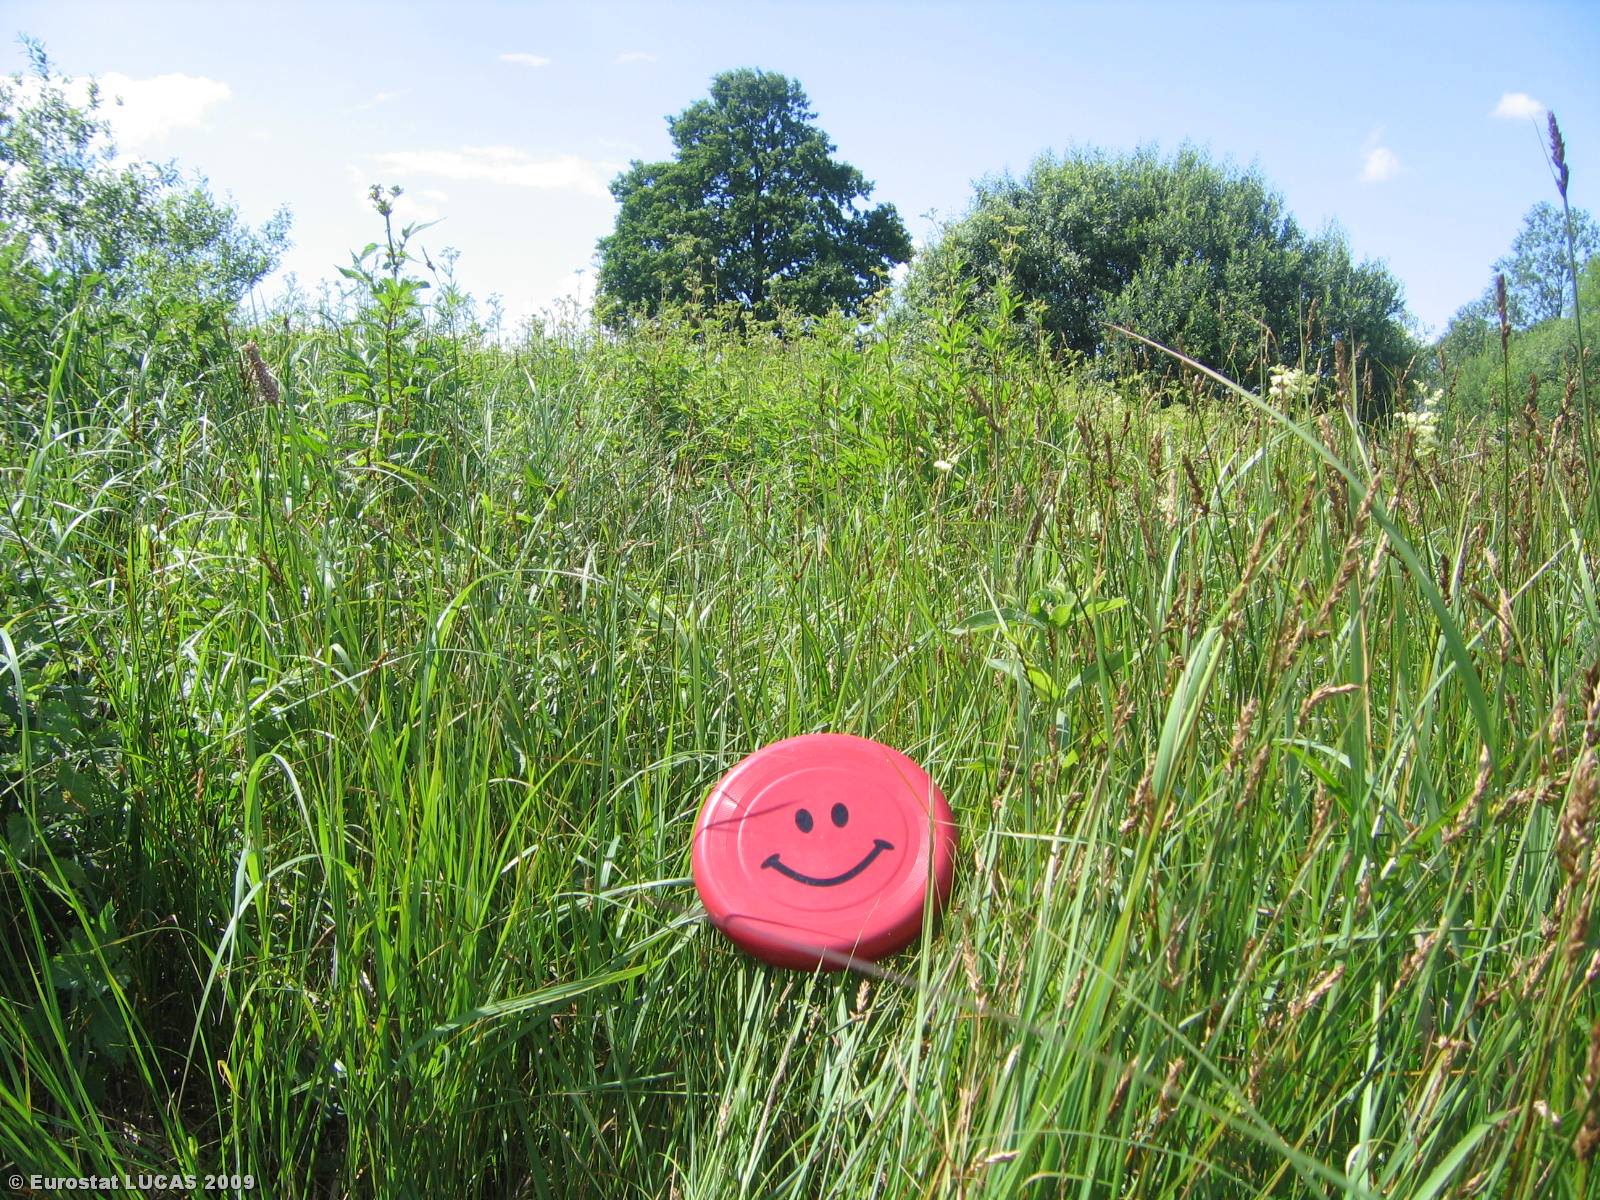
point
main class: Grassland
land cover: Grassland with sparse tree/shrub cover
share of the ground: > 75 %
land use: Agriculture (excluding fallow land and kitchen gardens)
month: July
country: LT
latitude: 55.4351
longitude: 22.7889
